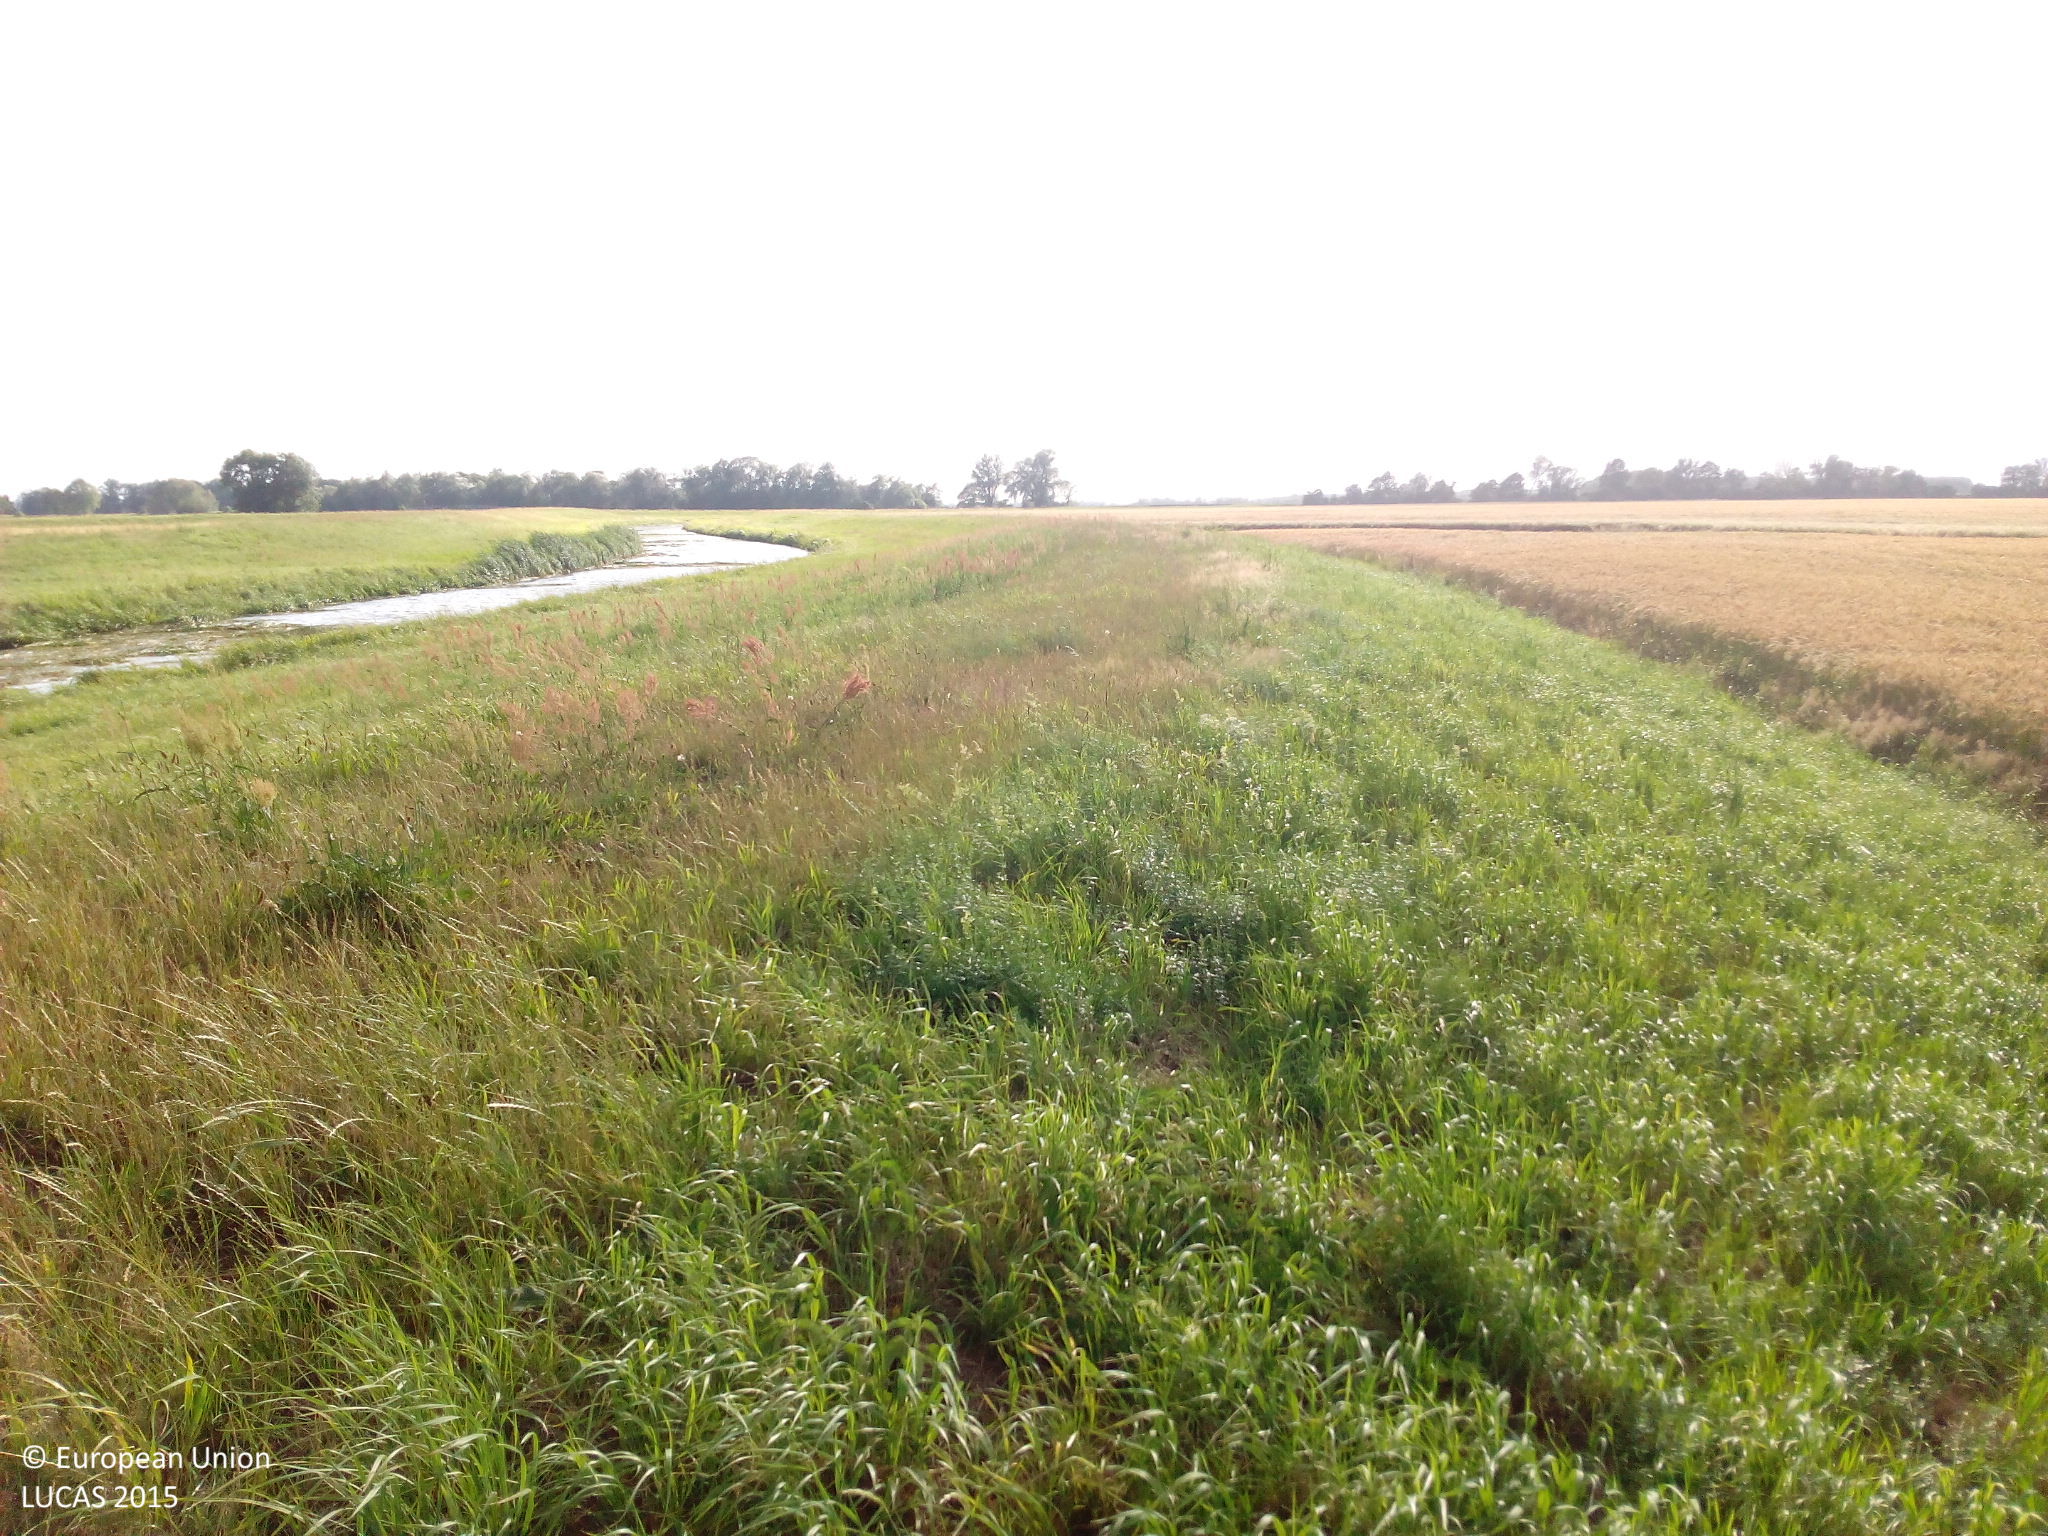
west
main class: Grassland
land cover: Grassland without tree/shrub cover
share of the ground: > 75 %
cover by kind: herbaceous plants 100 %
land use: Protection infrastructures
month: July
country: DE
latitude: 52.7862
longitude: 12.3274
